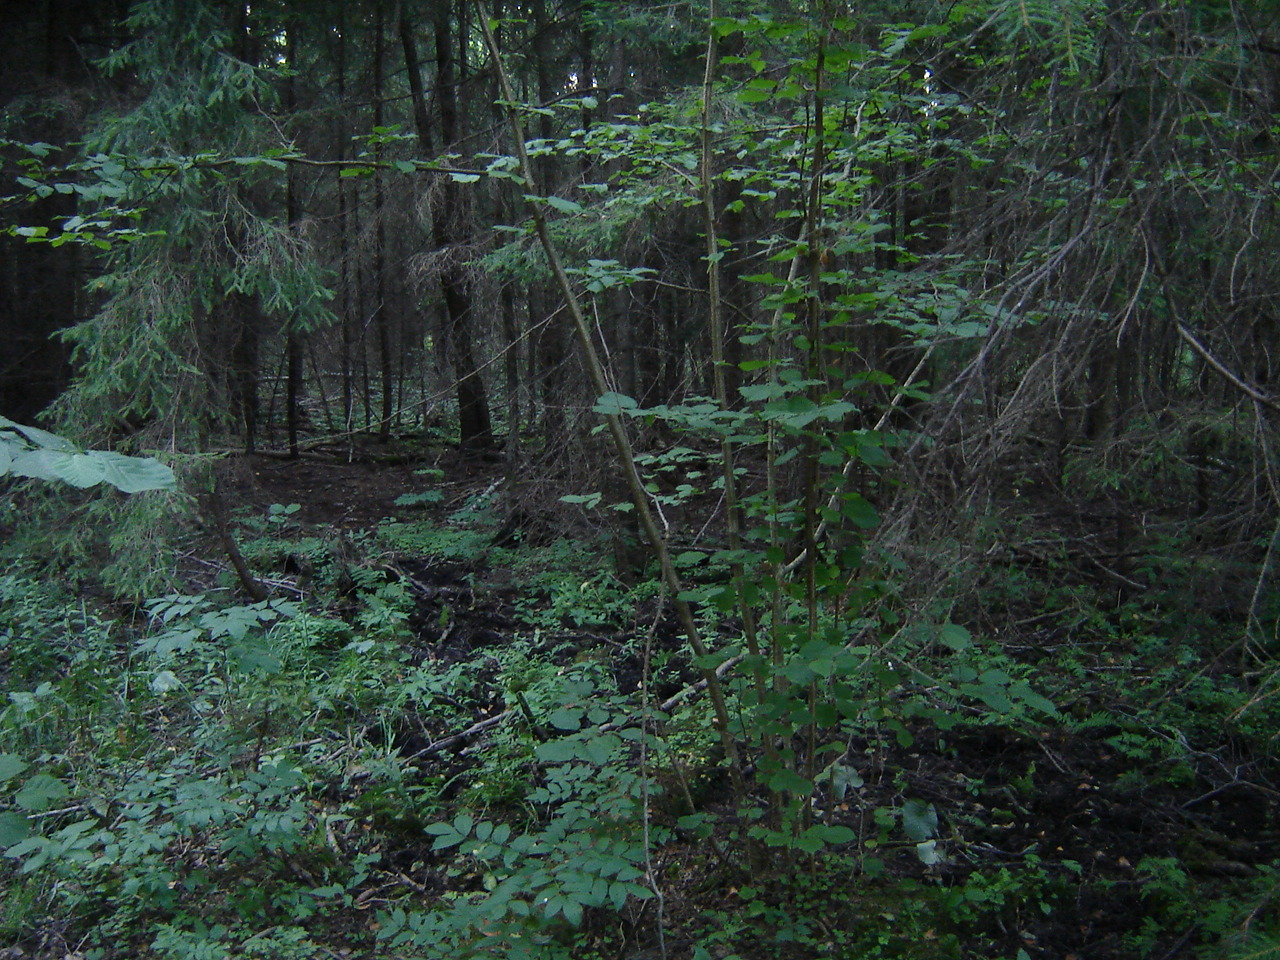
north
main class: Woodland
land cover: Other mixed woodland
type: hemiboreal forest and nemoral coniferous forest and mixed broadleaved-coniferous forest
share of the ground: > 75 %
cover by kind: broadleaved forest trees 50 %, coniferous forest trees 45 %, lichens and mosses 5 %
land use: Forestry
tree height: > 5 m
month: August
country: LT
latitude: 55.0528
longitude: 25.0640
